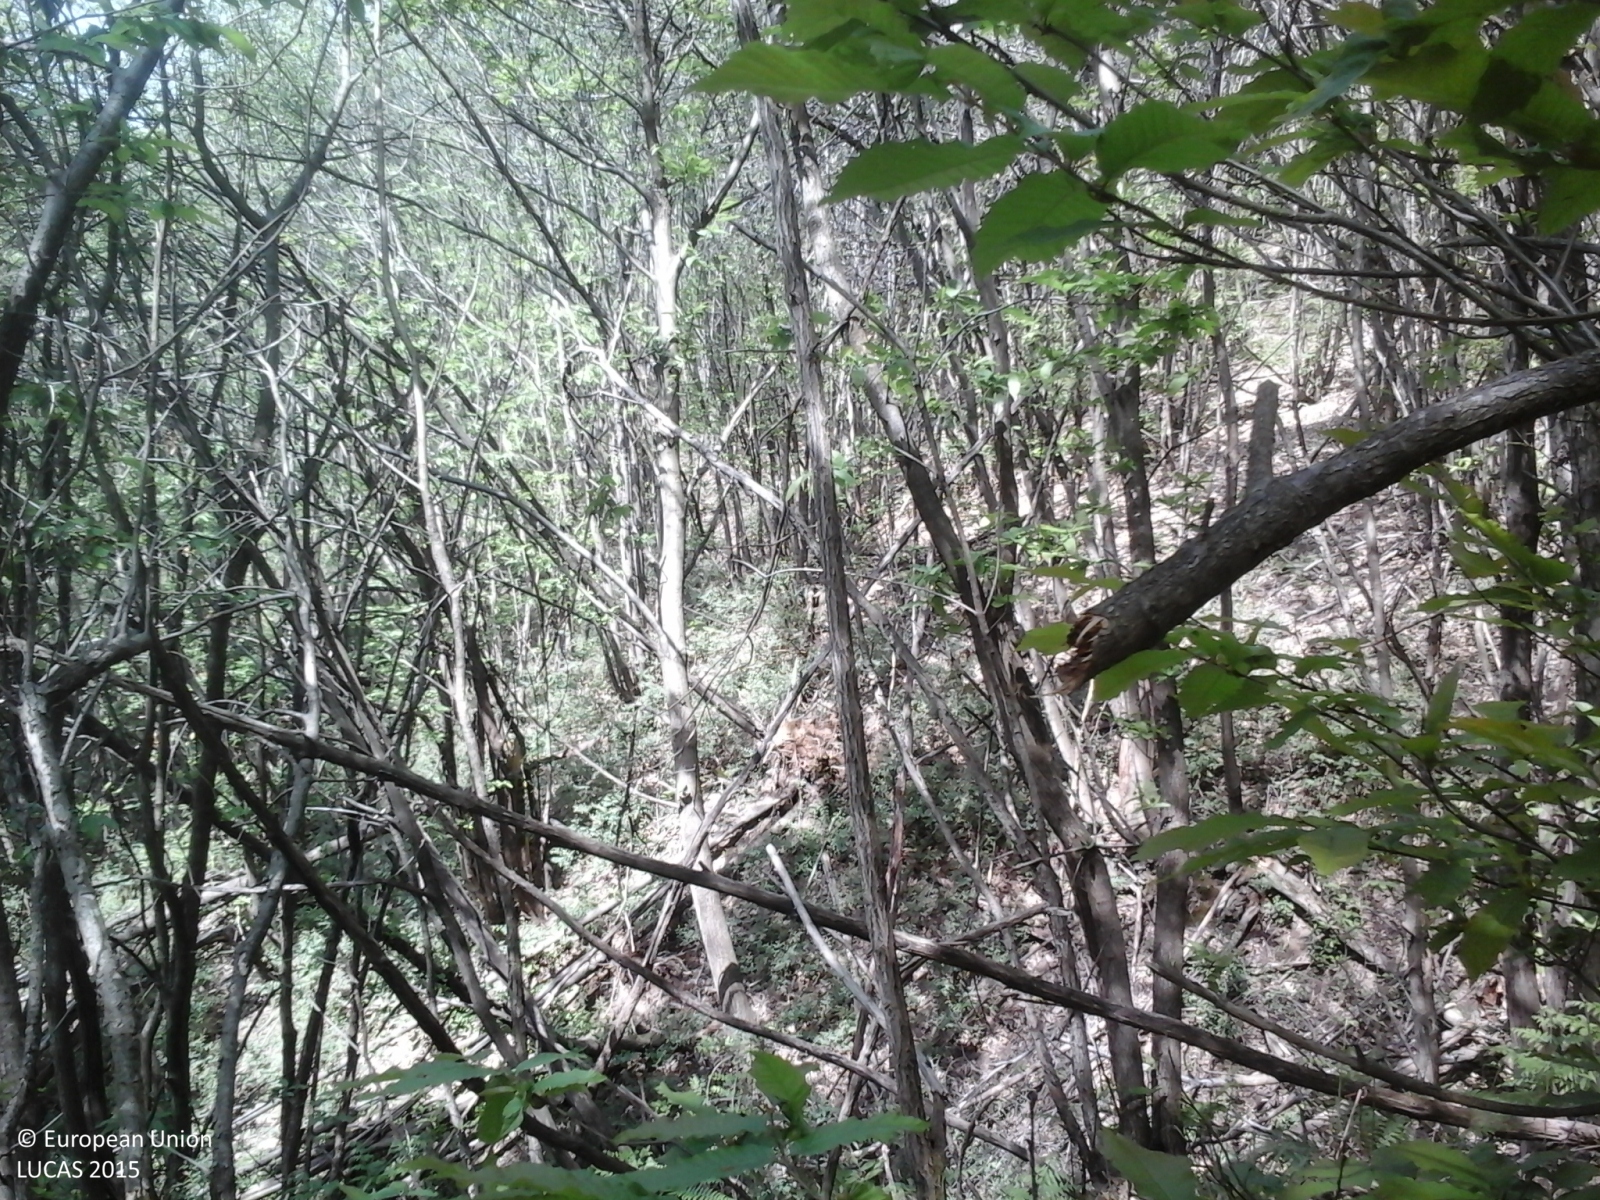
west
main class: Woodland
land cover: Broadleaved woodland
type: thermophilous deciduous forest
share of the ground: > 75 %
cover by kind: broadleaved forest trees 100 %
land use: Forestry
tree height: > 5 m
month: May
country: IT
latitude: 45.7442
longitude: 8.3701
